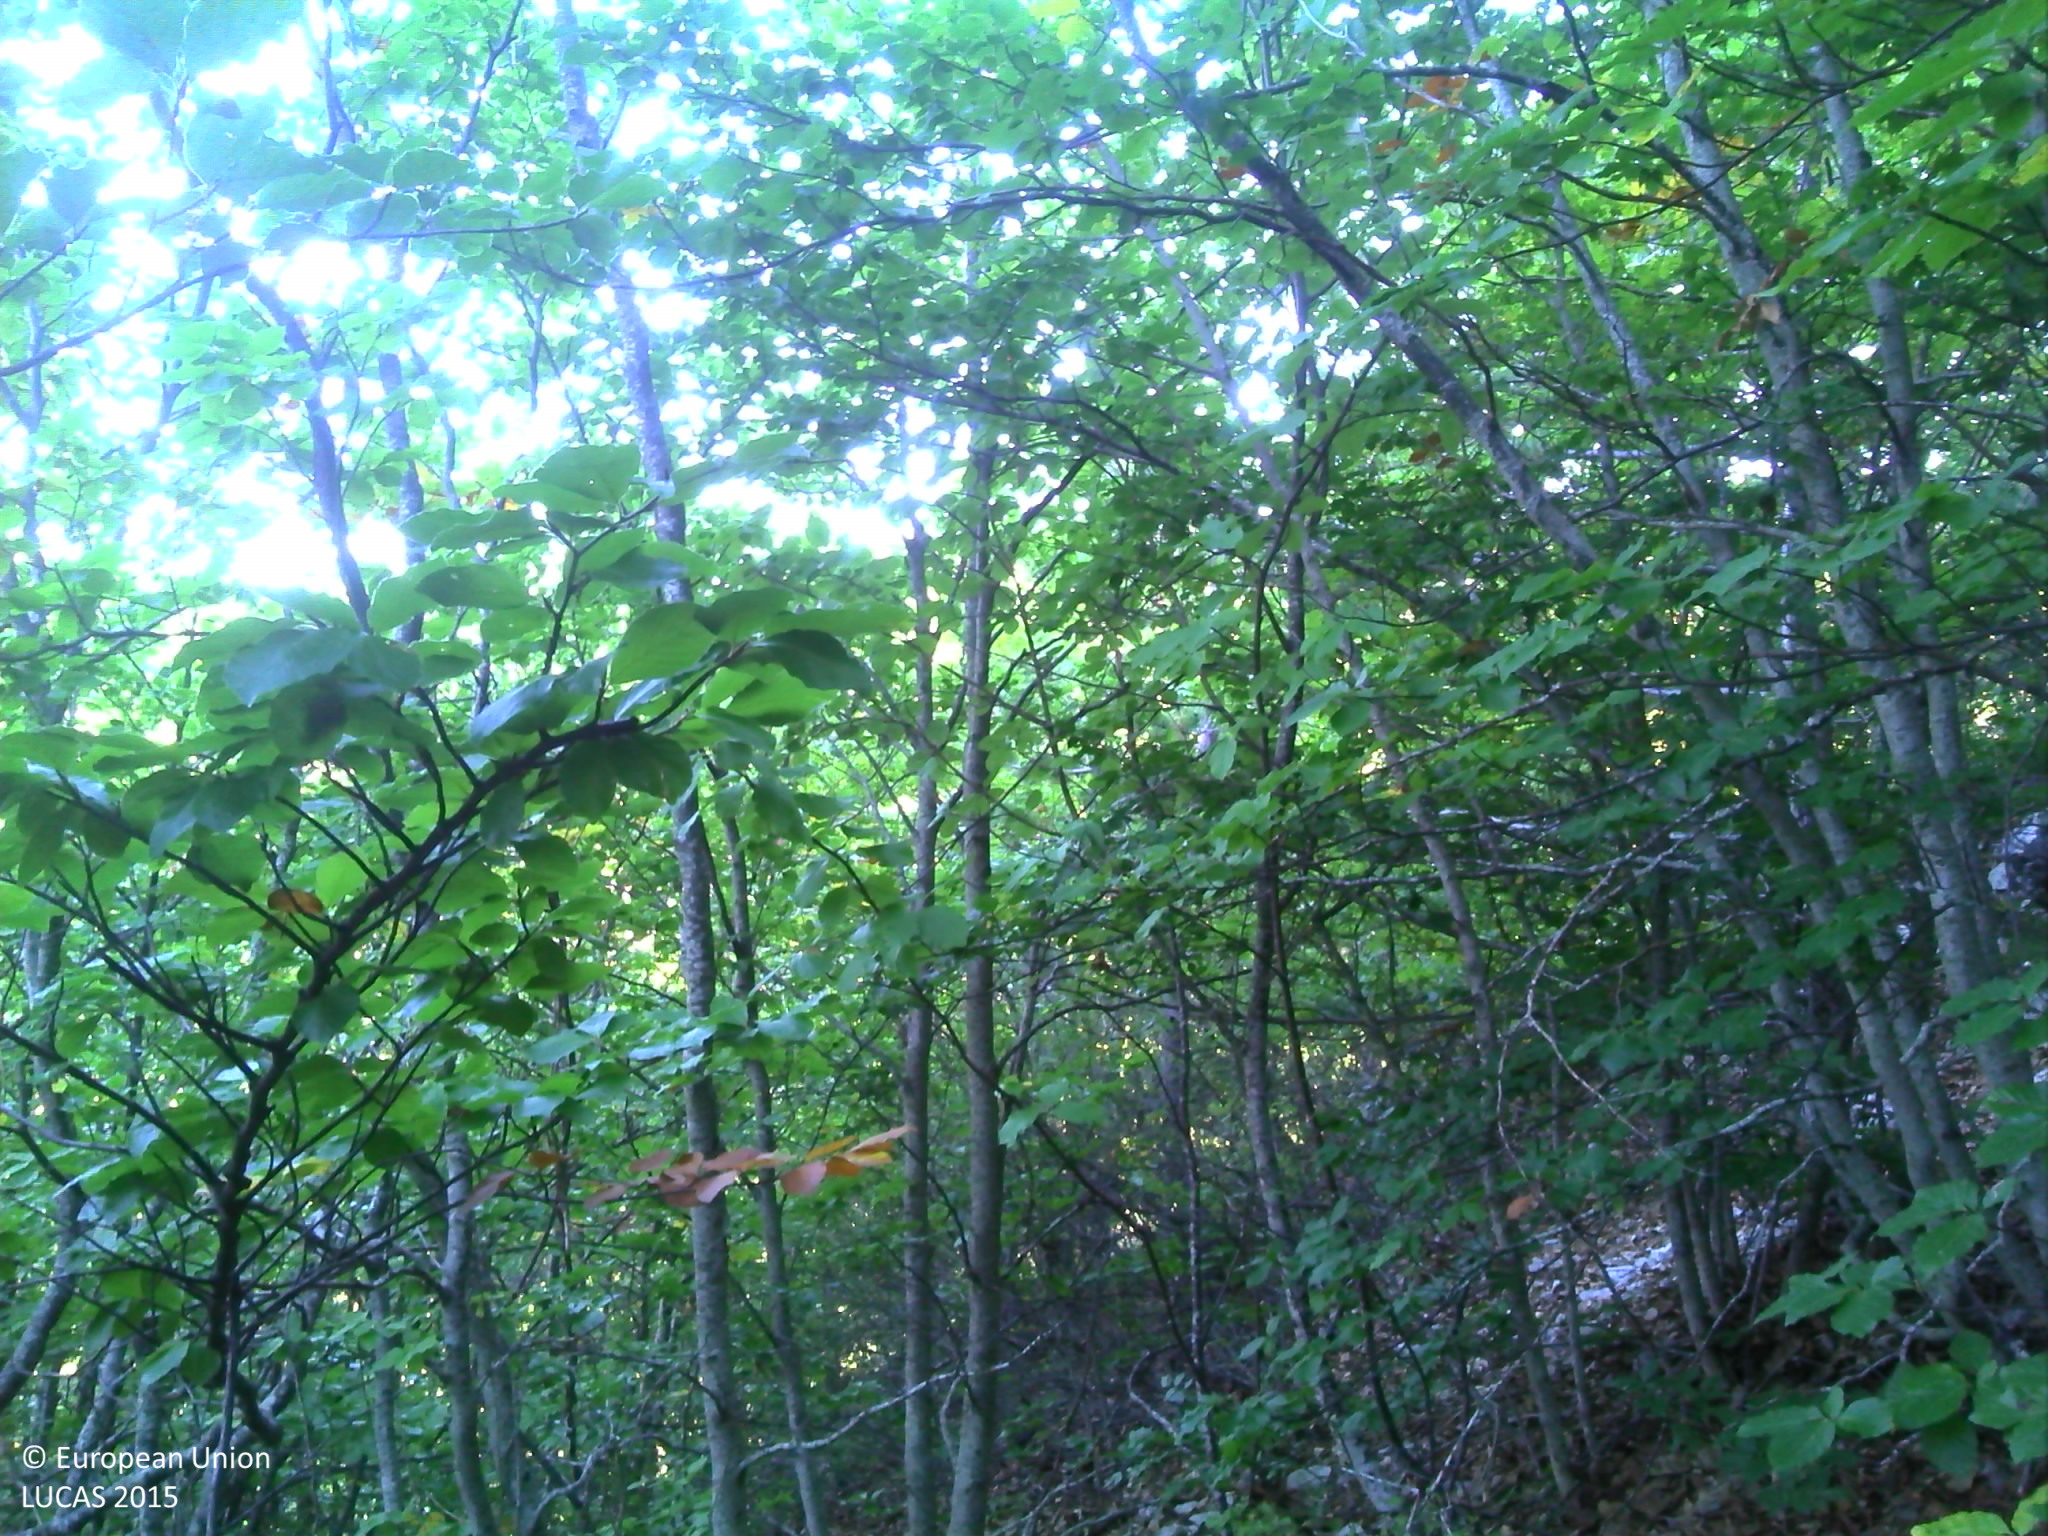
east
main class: Woodland
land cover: Broadleaved woodland
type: beech forest
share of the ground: > 75 %
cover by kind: broadleaved forest trees 85 %, unconsolidated bare surface 10 %, coniferous forest trees 5 %
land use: Semi-natural and natural areas not in use
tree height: > 5 m
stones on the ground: 10 - 25 %
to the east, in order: Broadleaved woodland; Tracks; Broadleaved woodland; Shrubland with sparse tree cover; Broadleaved woodland; Rivers and streams; Broadleaved woodland; Tracks; Broadleaved woodland; Tracks; Broadleaved woodland
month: September
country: FR
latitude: 44.1815
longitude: 5.5171
